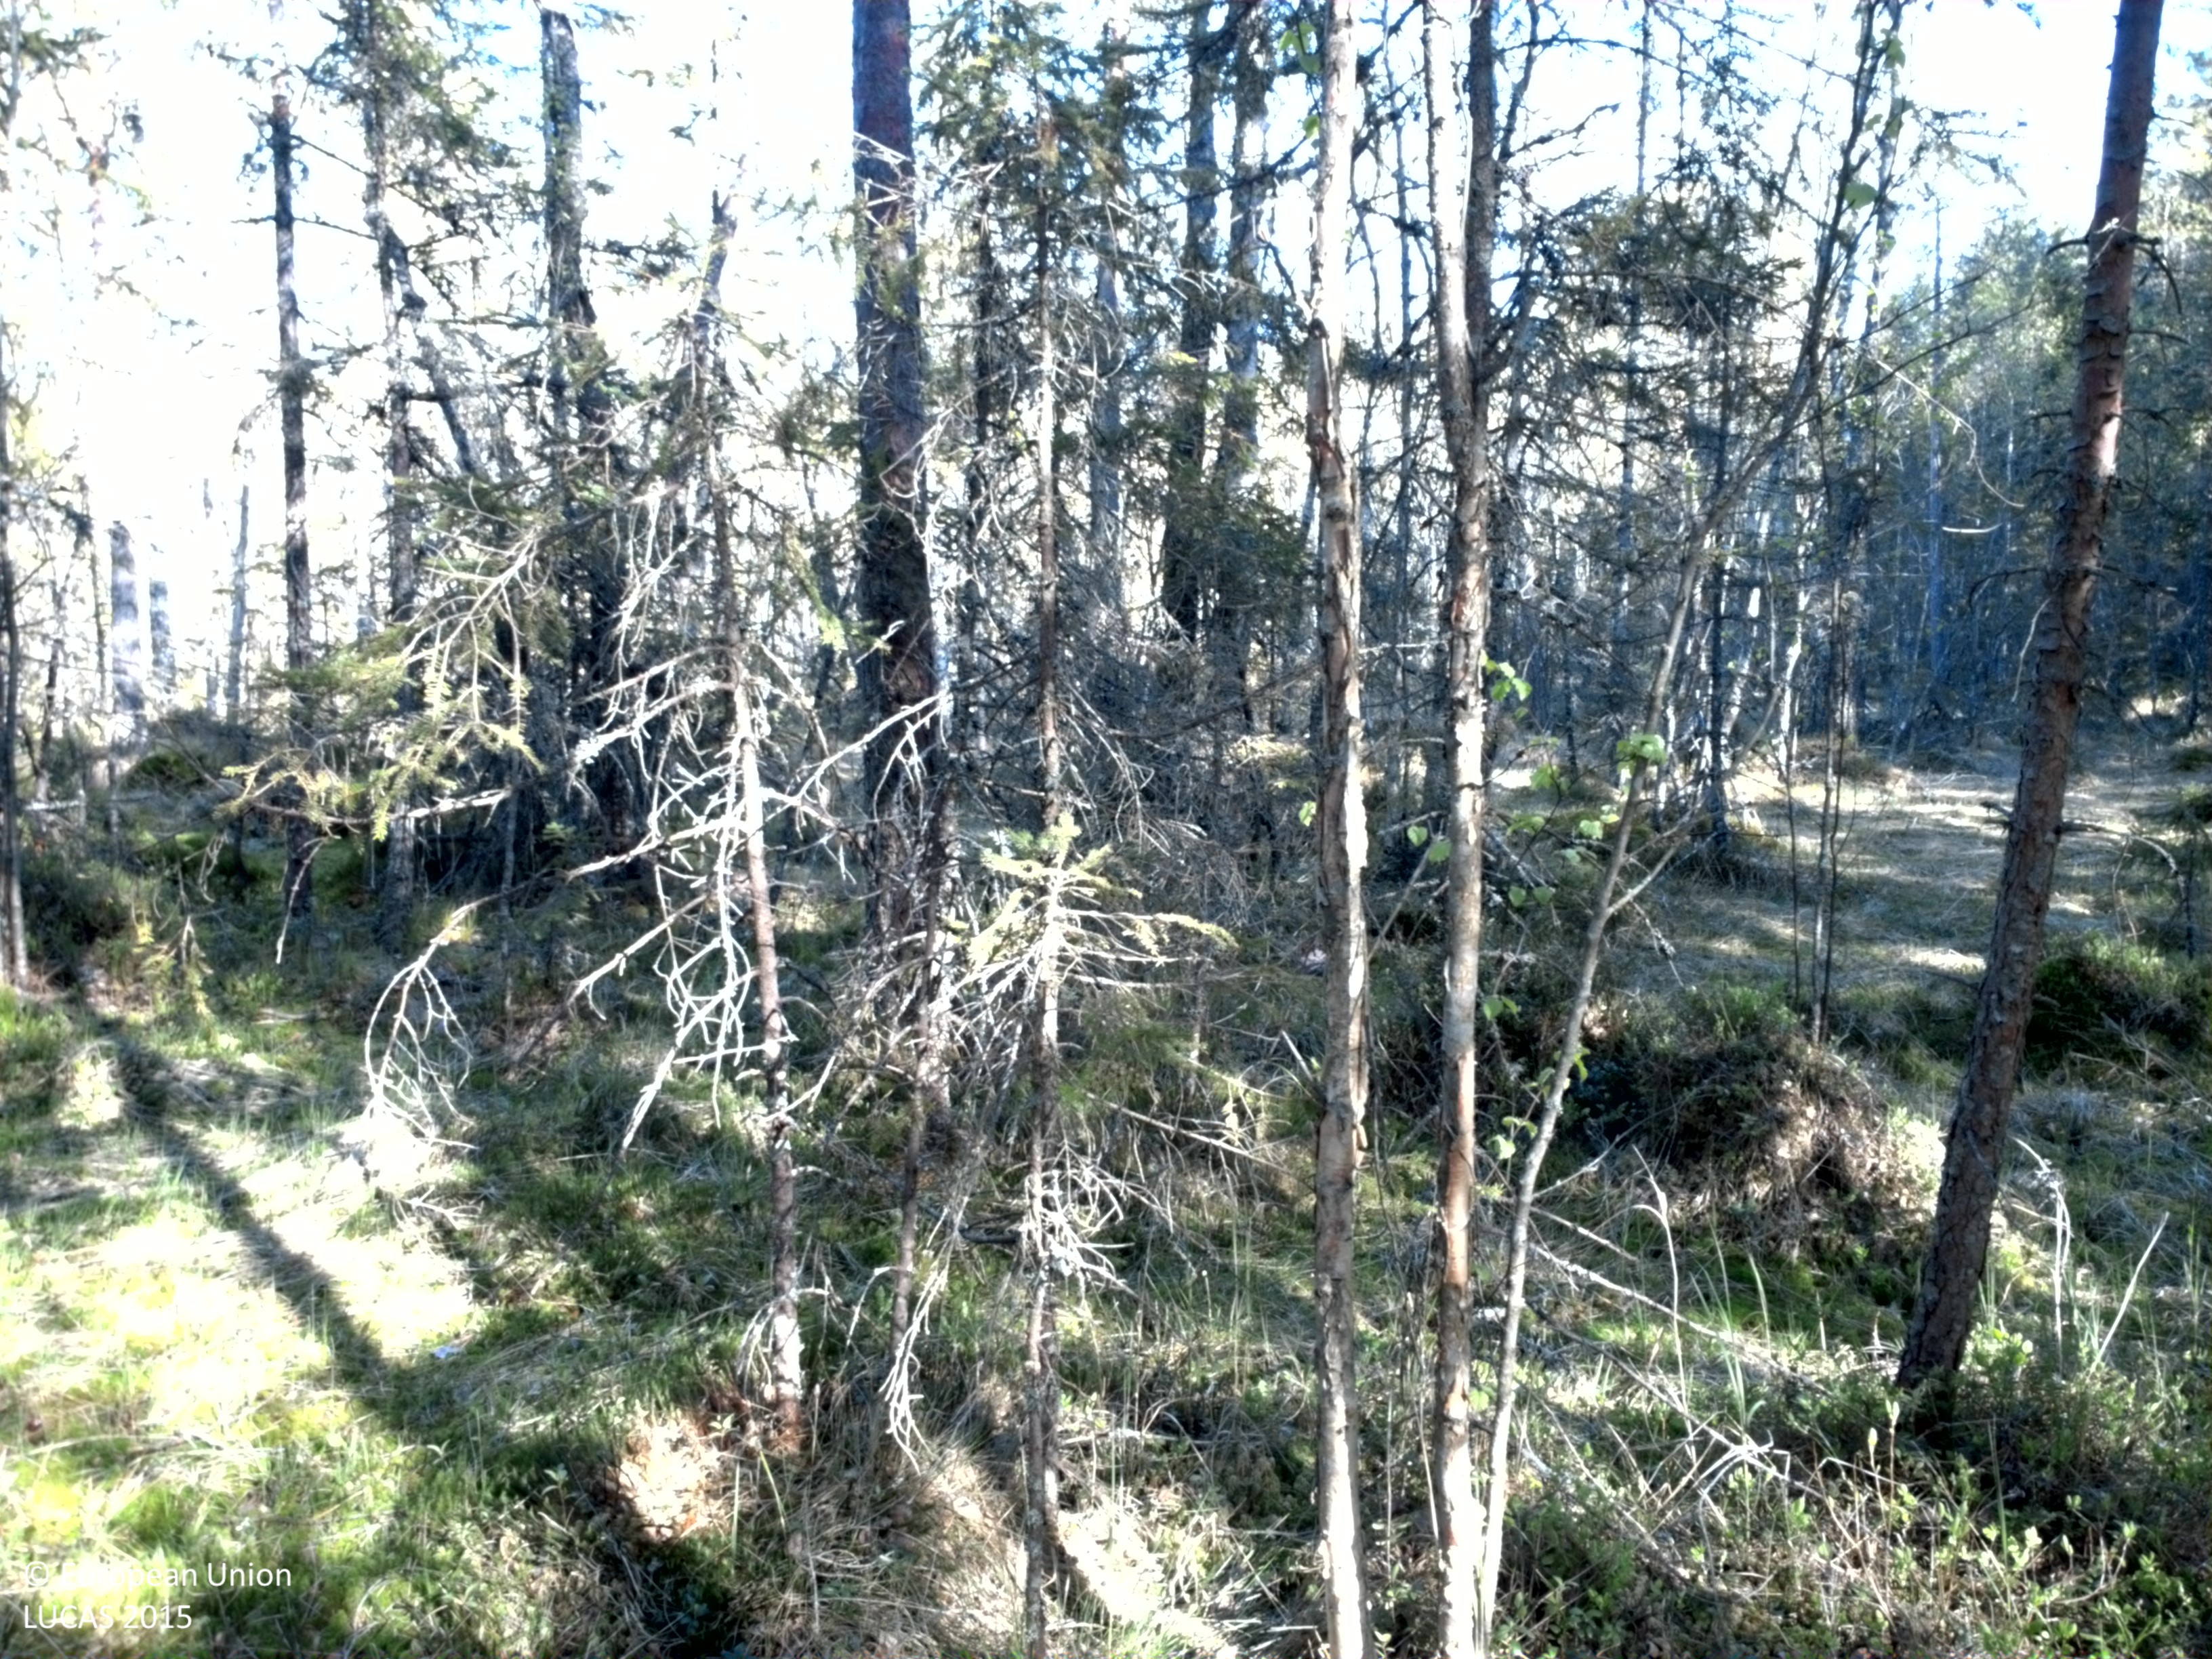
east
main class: Woodland
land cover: Spruce dominated coniferous woodland
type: boreal forest
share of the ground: > 75 %
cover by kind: coniferous forest trees 80 %, lichens and mosses 10 %, broadleaved forest trees 5 %, shrubs 5 %
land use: Forestry
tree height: > 5 m
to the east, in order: Spruce dominated coniferous woodland; Broadleaved woodland; Shrubland with sparse tree cover; Broadleaved woodland; Shrubland with sparse tree cover; Pine dominated coniferous woodland
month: May
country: SE
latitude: 59.4943
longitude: 12.3782
